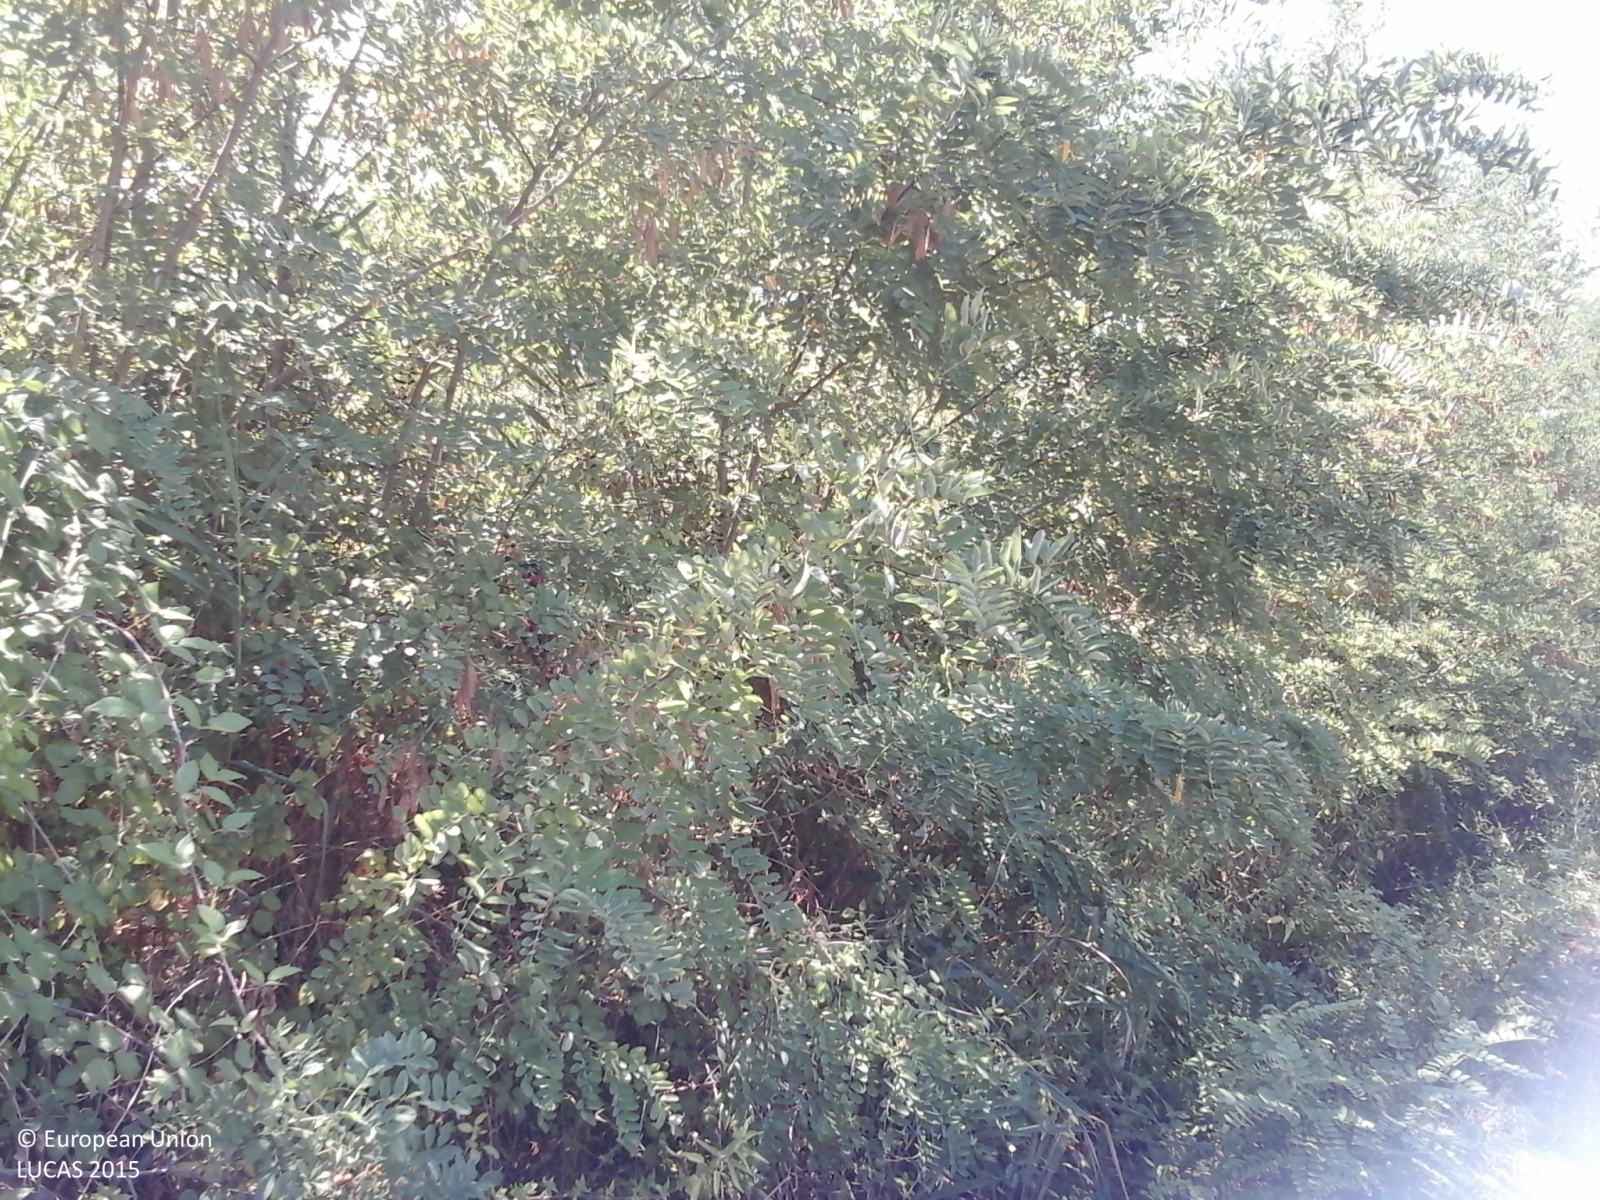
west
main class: Cropland
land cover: Other fruit trees and berries
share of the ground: 50 - 75 %
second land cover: Other bare soil
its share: > 75 %
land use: Agriculture (excluding fallow land and kitchen gardens)
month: July
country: IT
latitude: 41.5256
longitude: 12.9724
